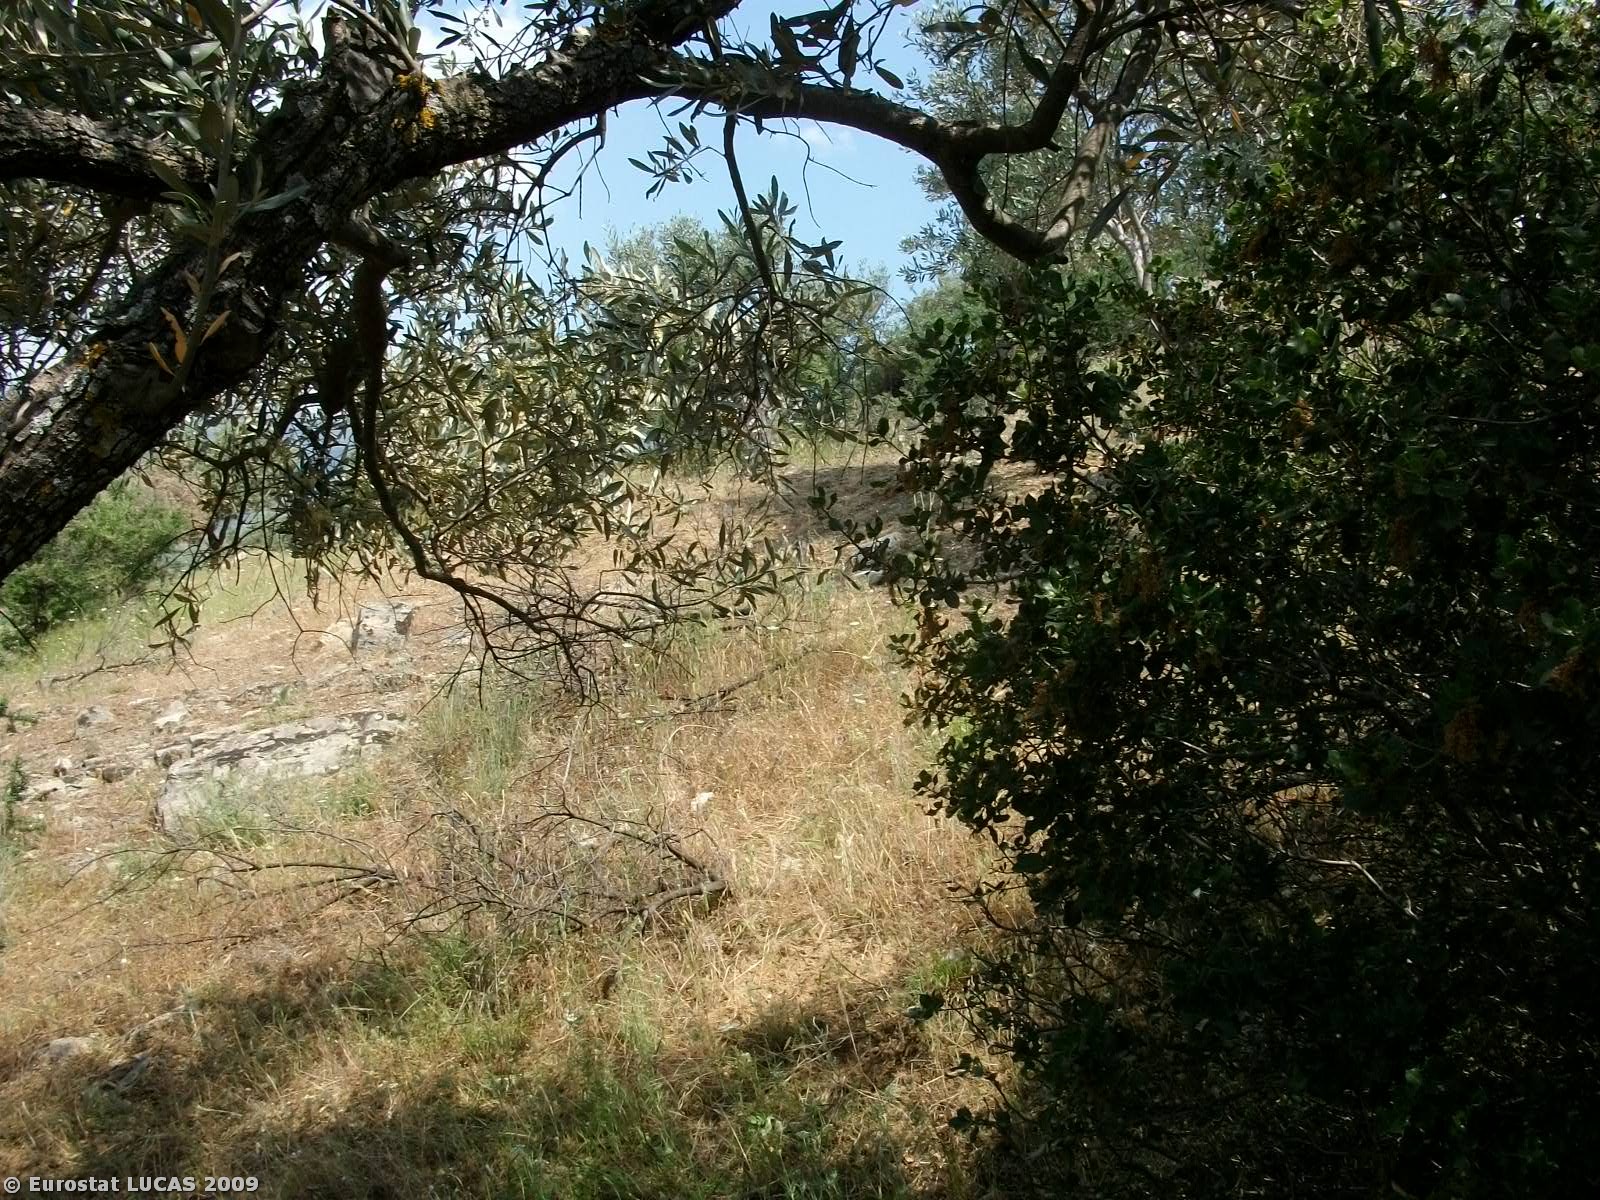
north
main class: Cropland
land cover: Olive groves
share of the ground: 25 - 50 %
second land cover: Grassland with sparse tree/shrub cover
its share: 50 - 75 %
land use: Agriculture (excluding fallow land and kitchen gardens)
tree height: < 5 m
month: May
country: GR
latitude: 39.8382
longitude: 22.4377
